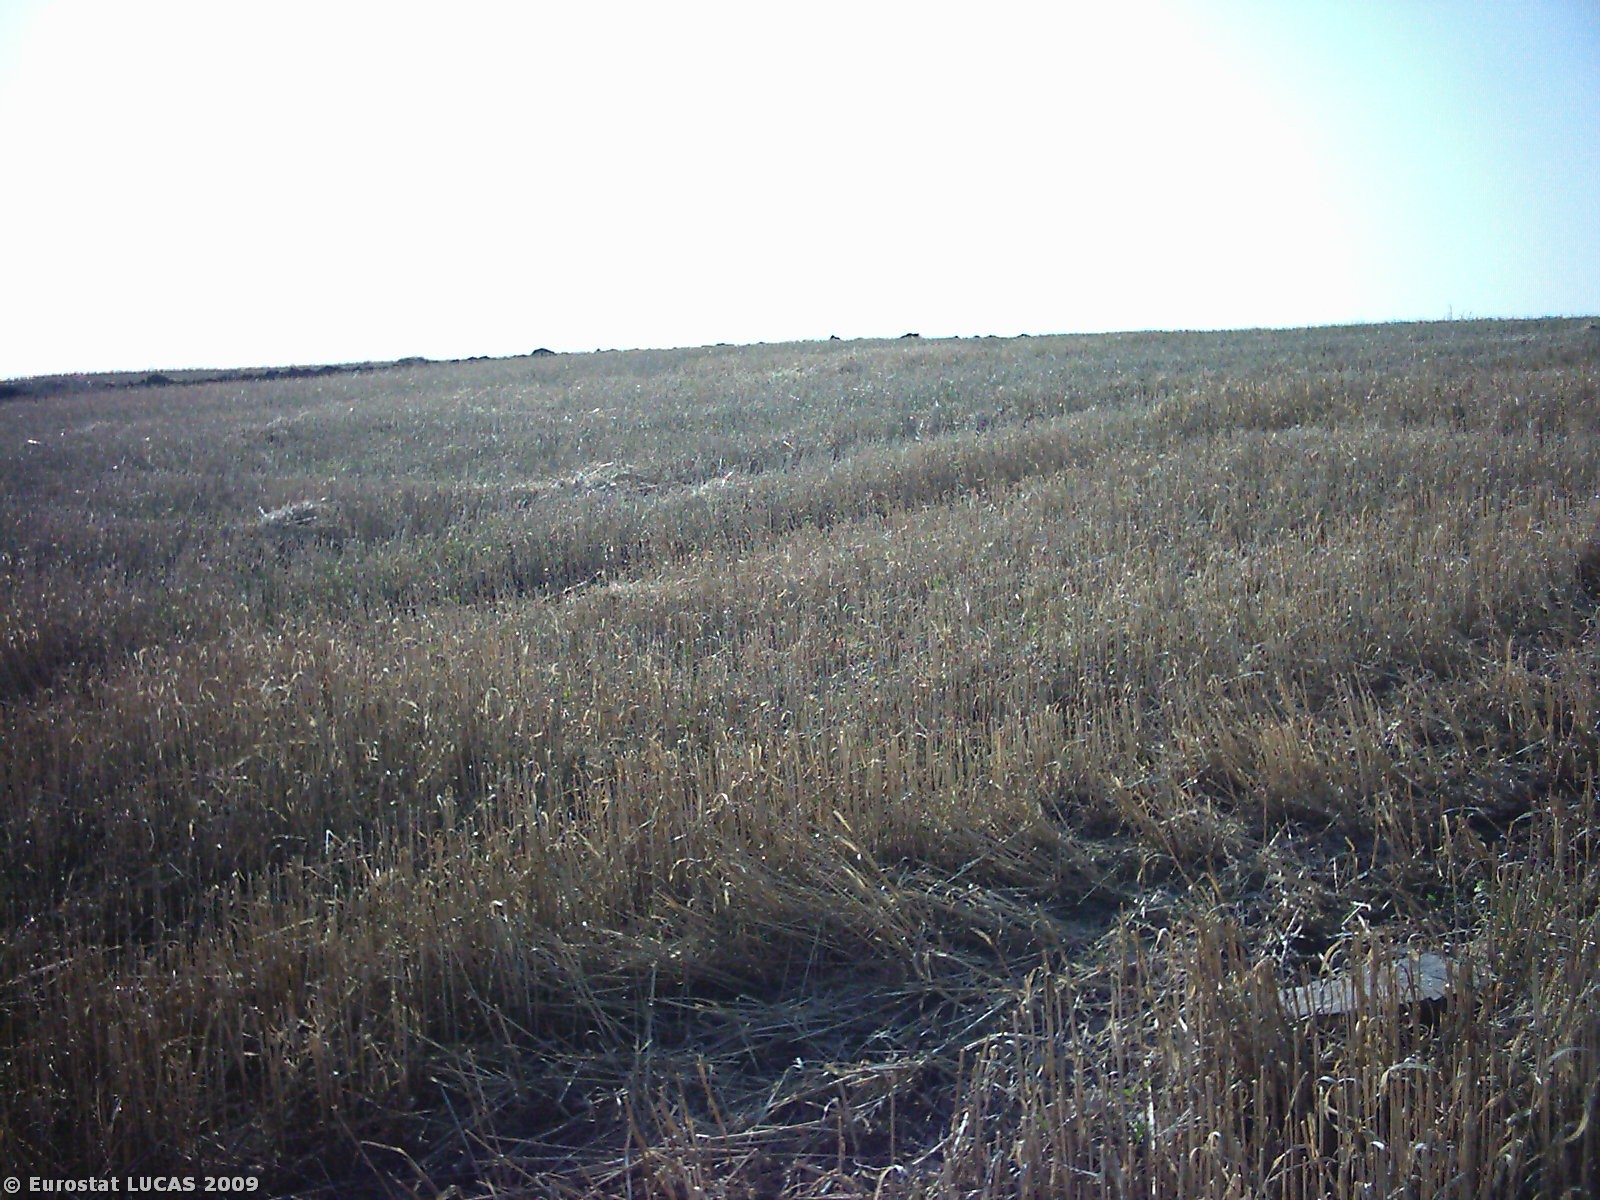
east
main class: Cropland
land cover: Durum wheat
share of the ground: < 10 %
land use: Agriculture (excluding fallow land and kitchen gardens)
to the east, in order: Durum wheat; Bare land; Durum wheat; Bare land; Durum wheat; Bare land; Durum wheat
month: July
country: IT
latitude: 41.1940
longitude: 15.6204
